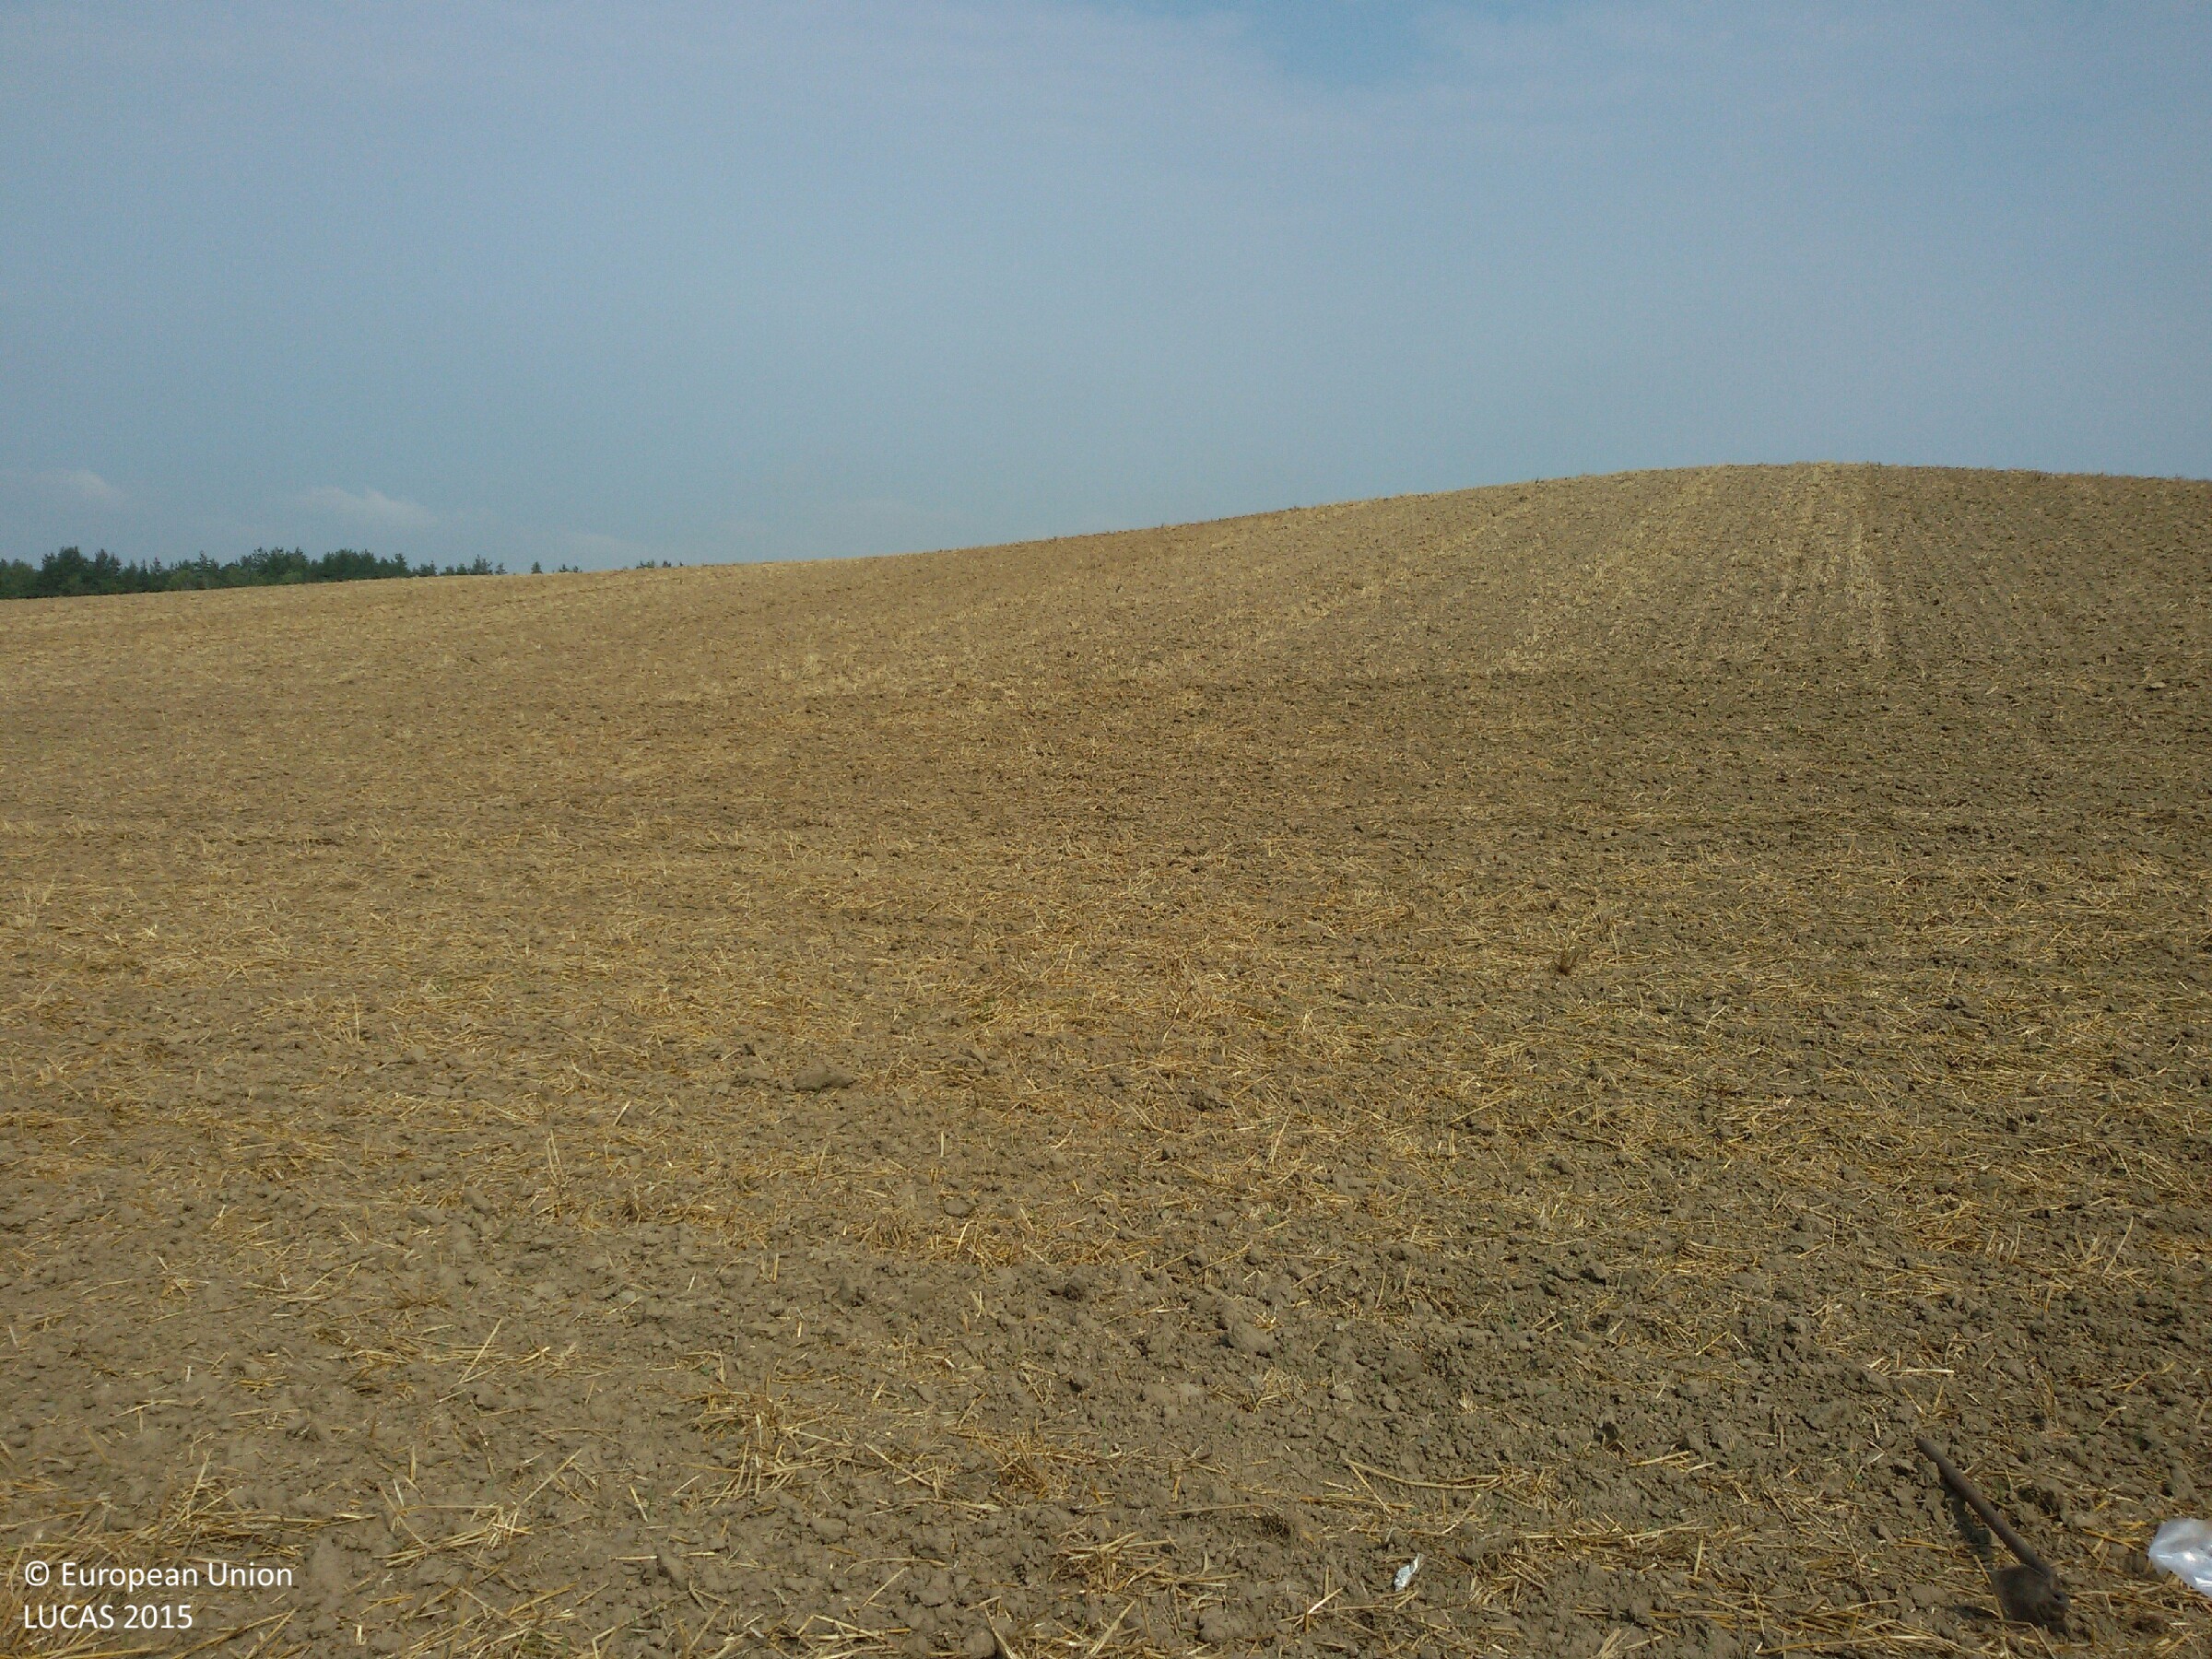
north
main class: Cropland
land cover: Common wheat
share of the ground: > 75 %
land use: Agriculture (excluding fallow land and kitchen gardens)
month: August
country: PL
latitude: 52.8704
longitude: 14.4433
